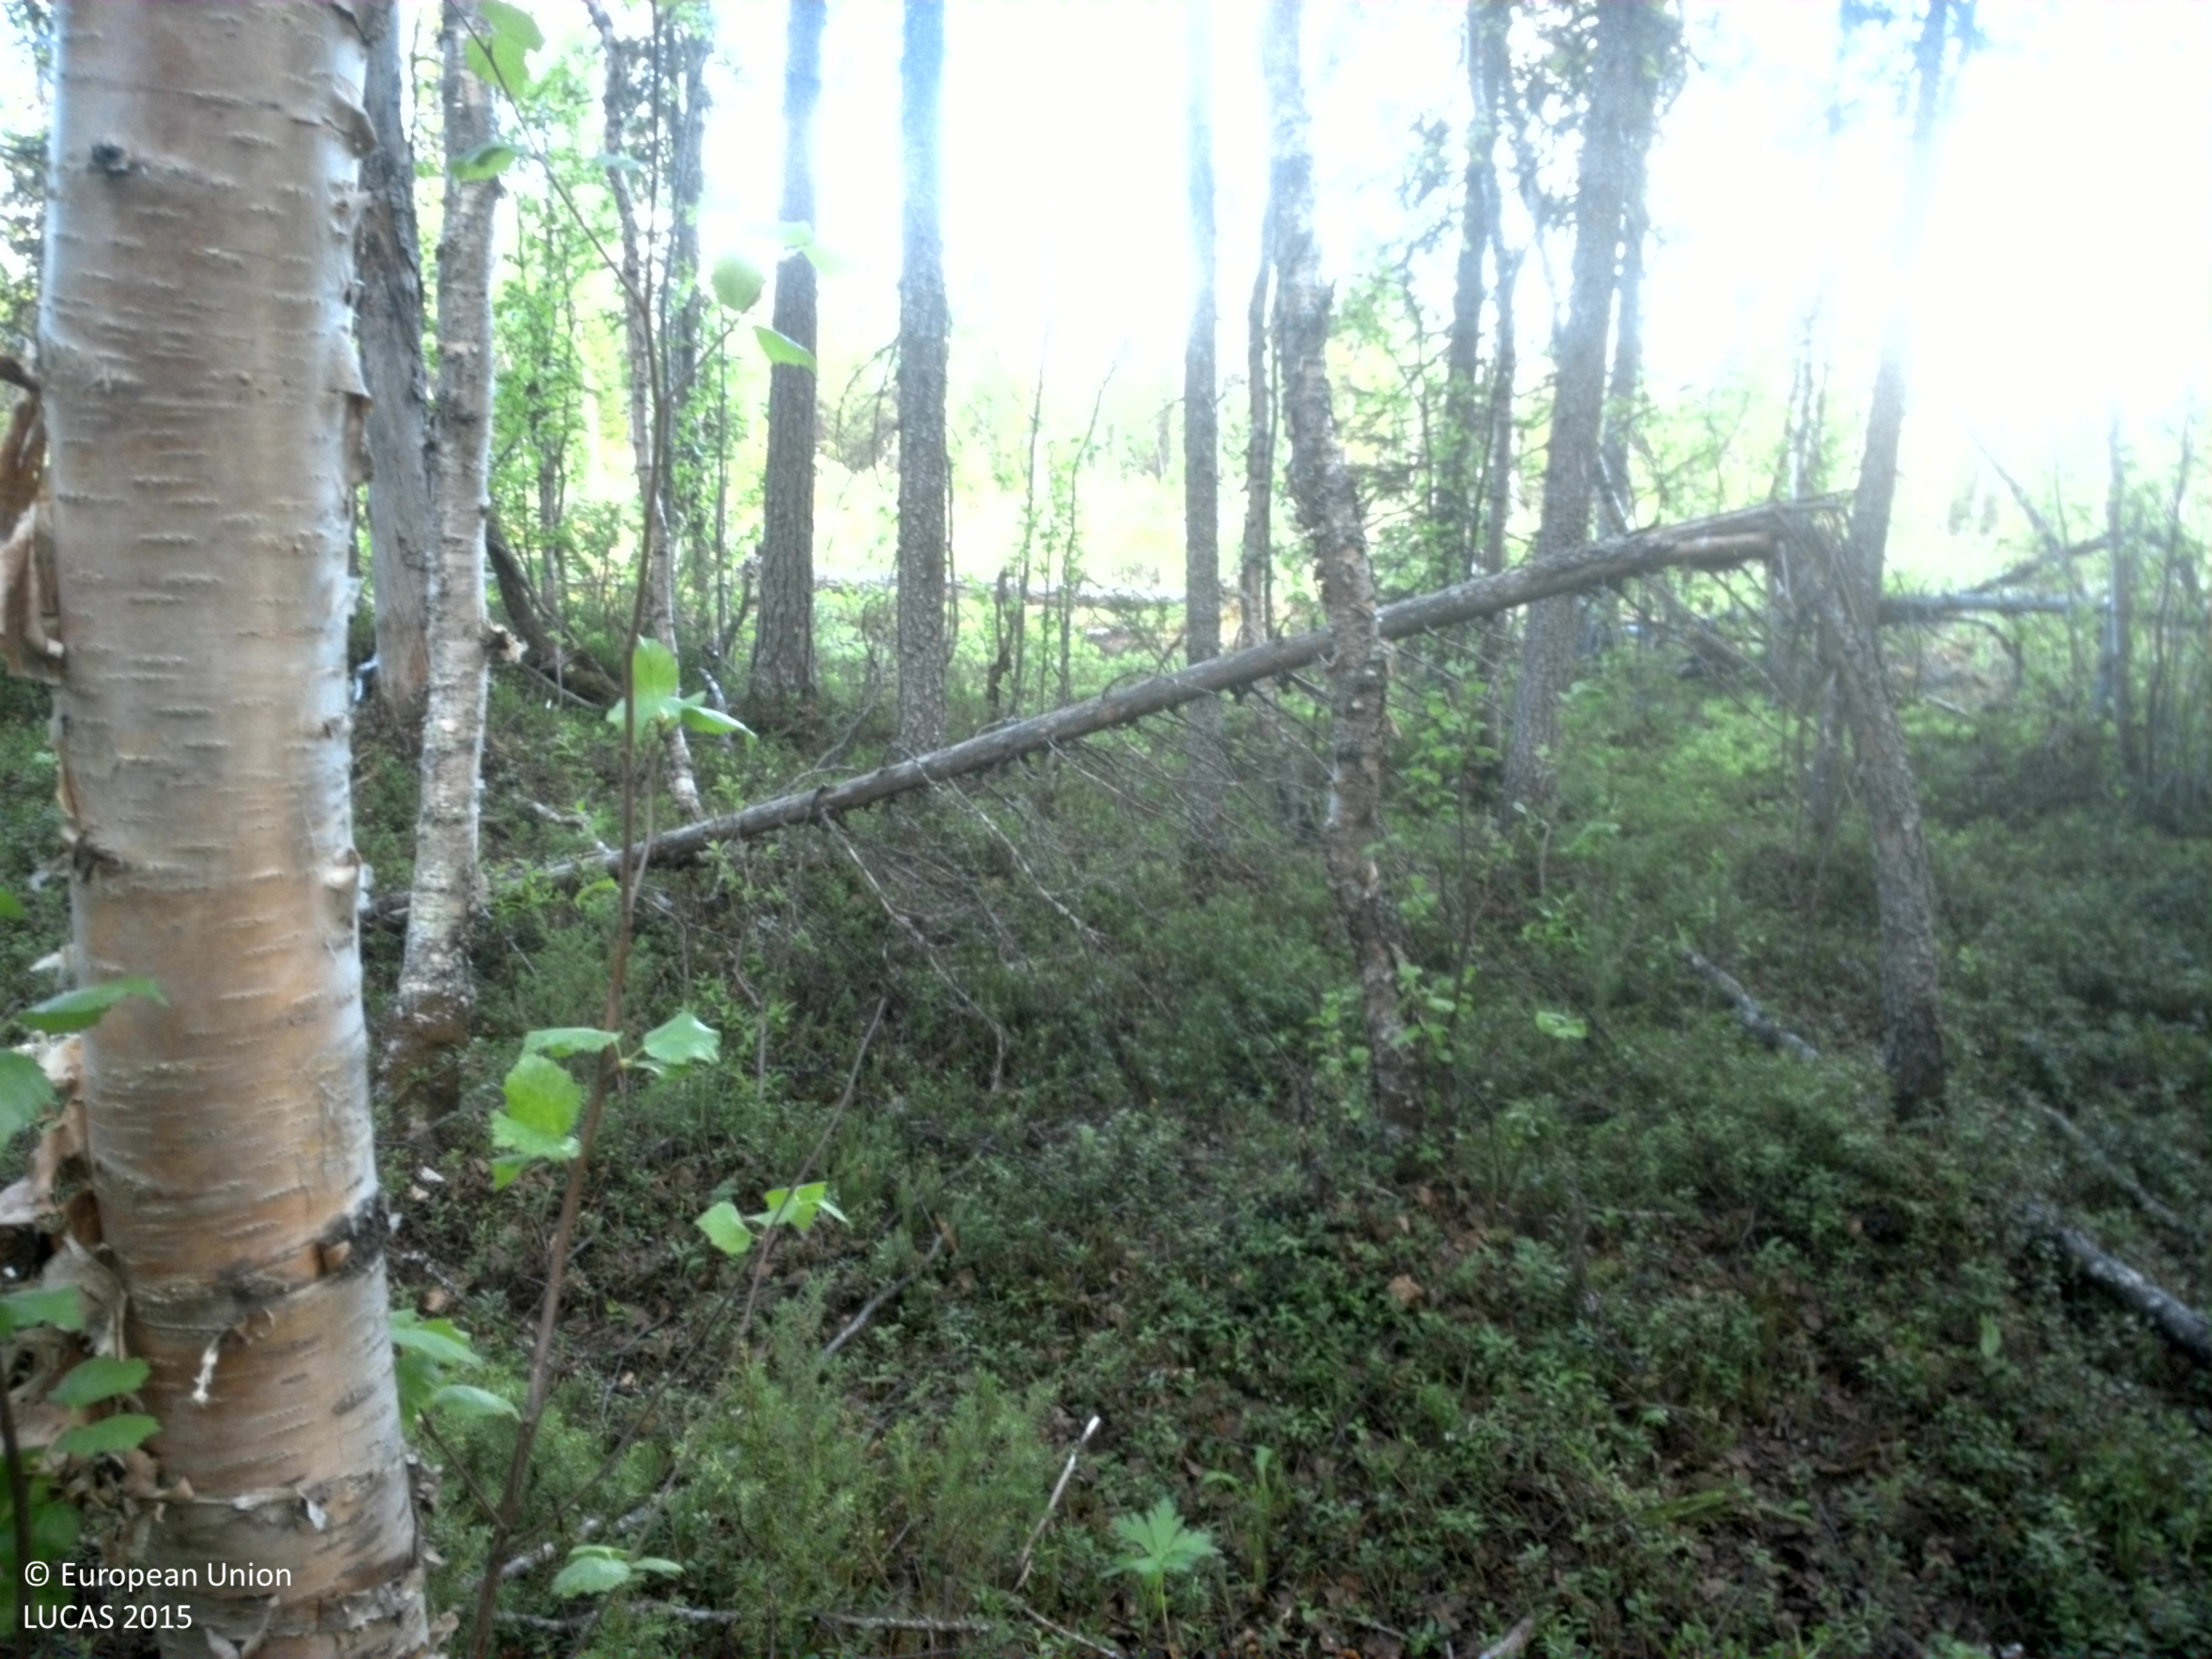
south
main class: Woodland
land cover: Spruce dominated mixed woodland
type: boreal forest
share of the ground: 50 - 75 %
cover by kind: shrubs 45 %, coniferous forest trees 35 %, broadleaved forest trees 15 %, herbaceous plants 5 %
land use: Forestry
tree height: > 5 m
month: June
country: SE
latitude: 67.0991
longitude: 21.6777
